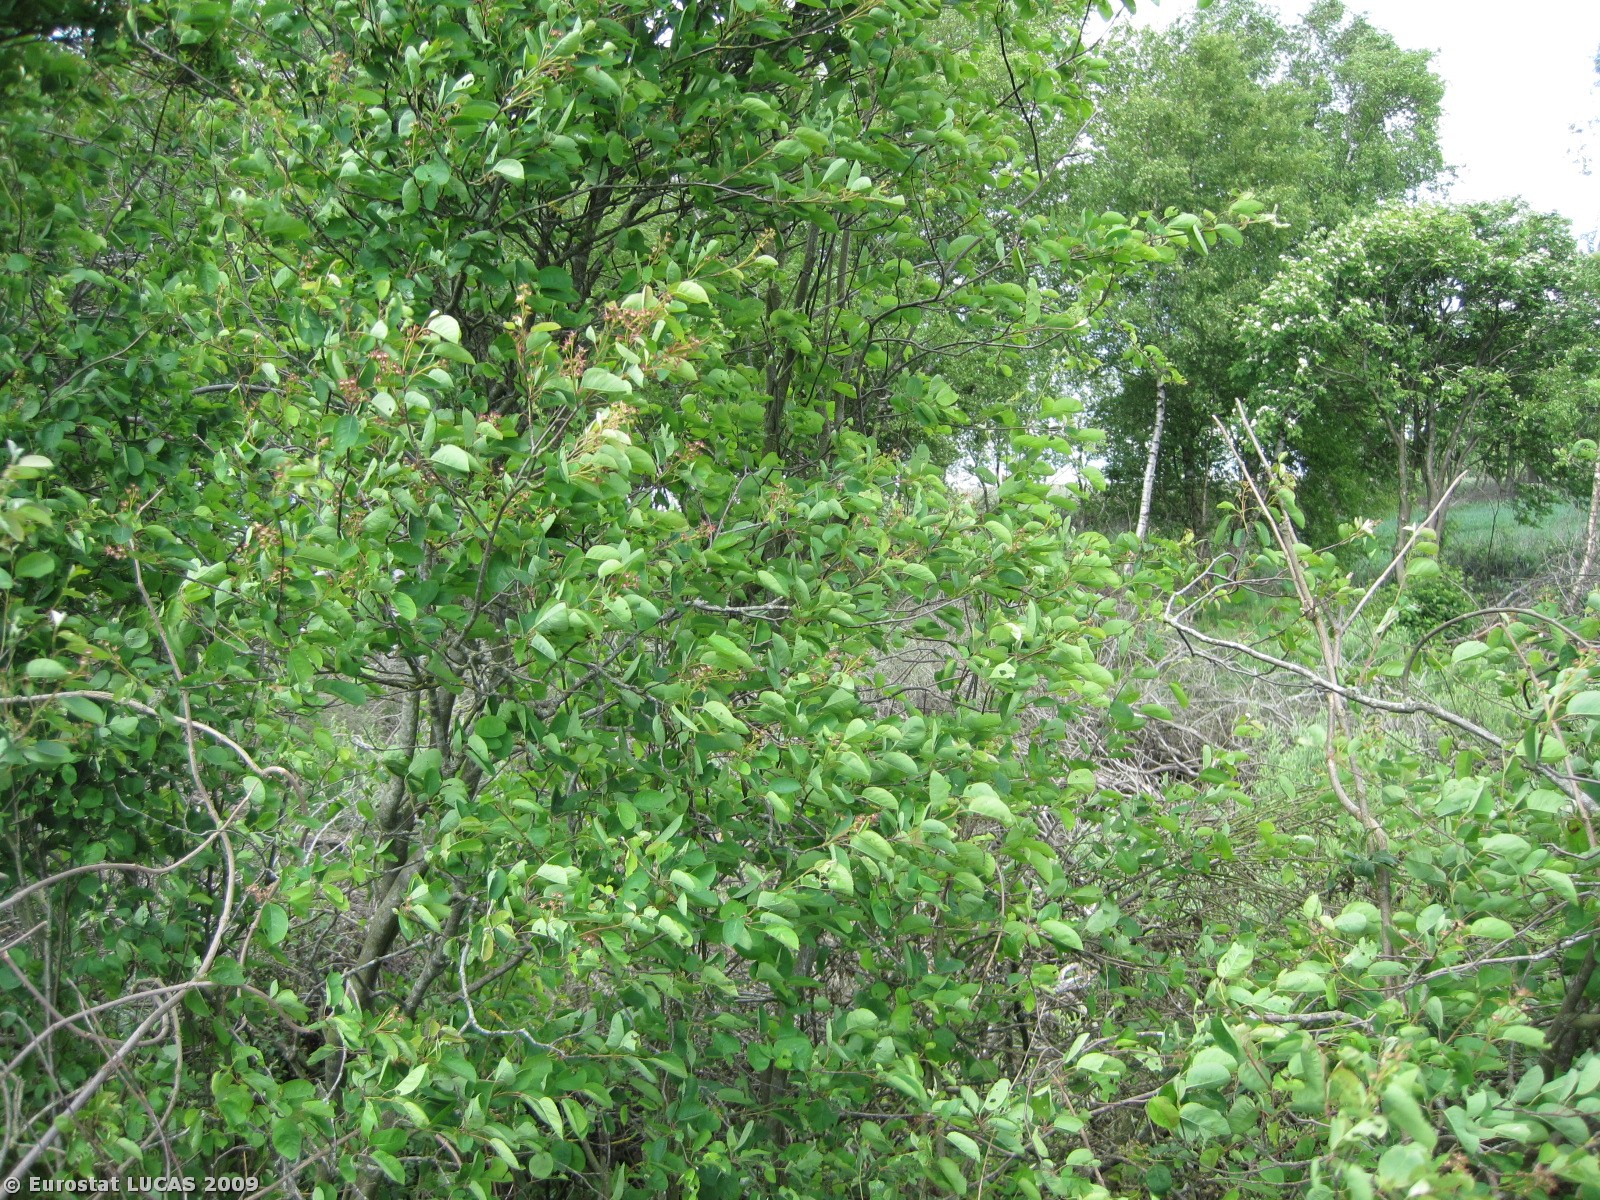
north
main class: Woodland
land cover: Broadleaved woodland
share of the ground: > 75 %
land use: Unused
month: May
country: DK
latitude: 56.7089
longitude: 9.7879
